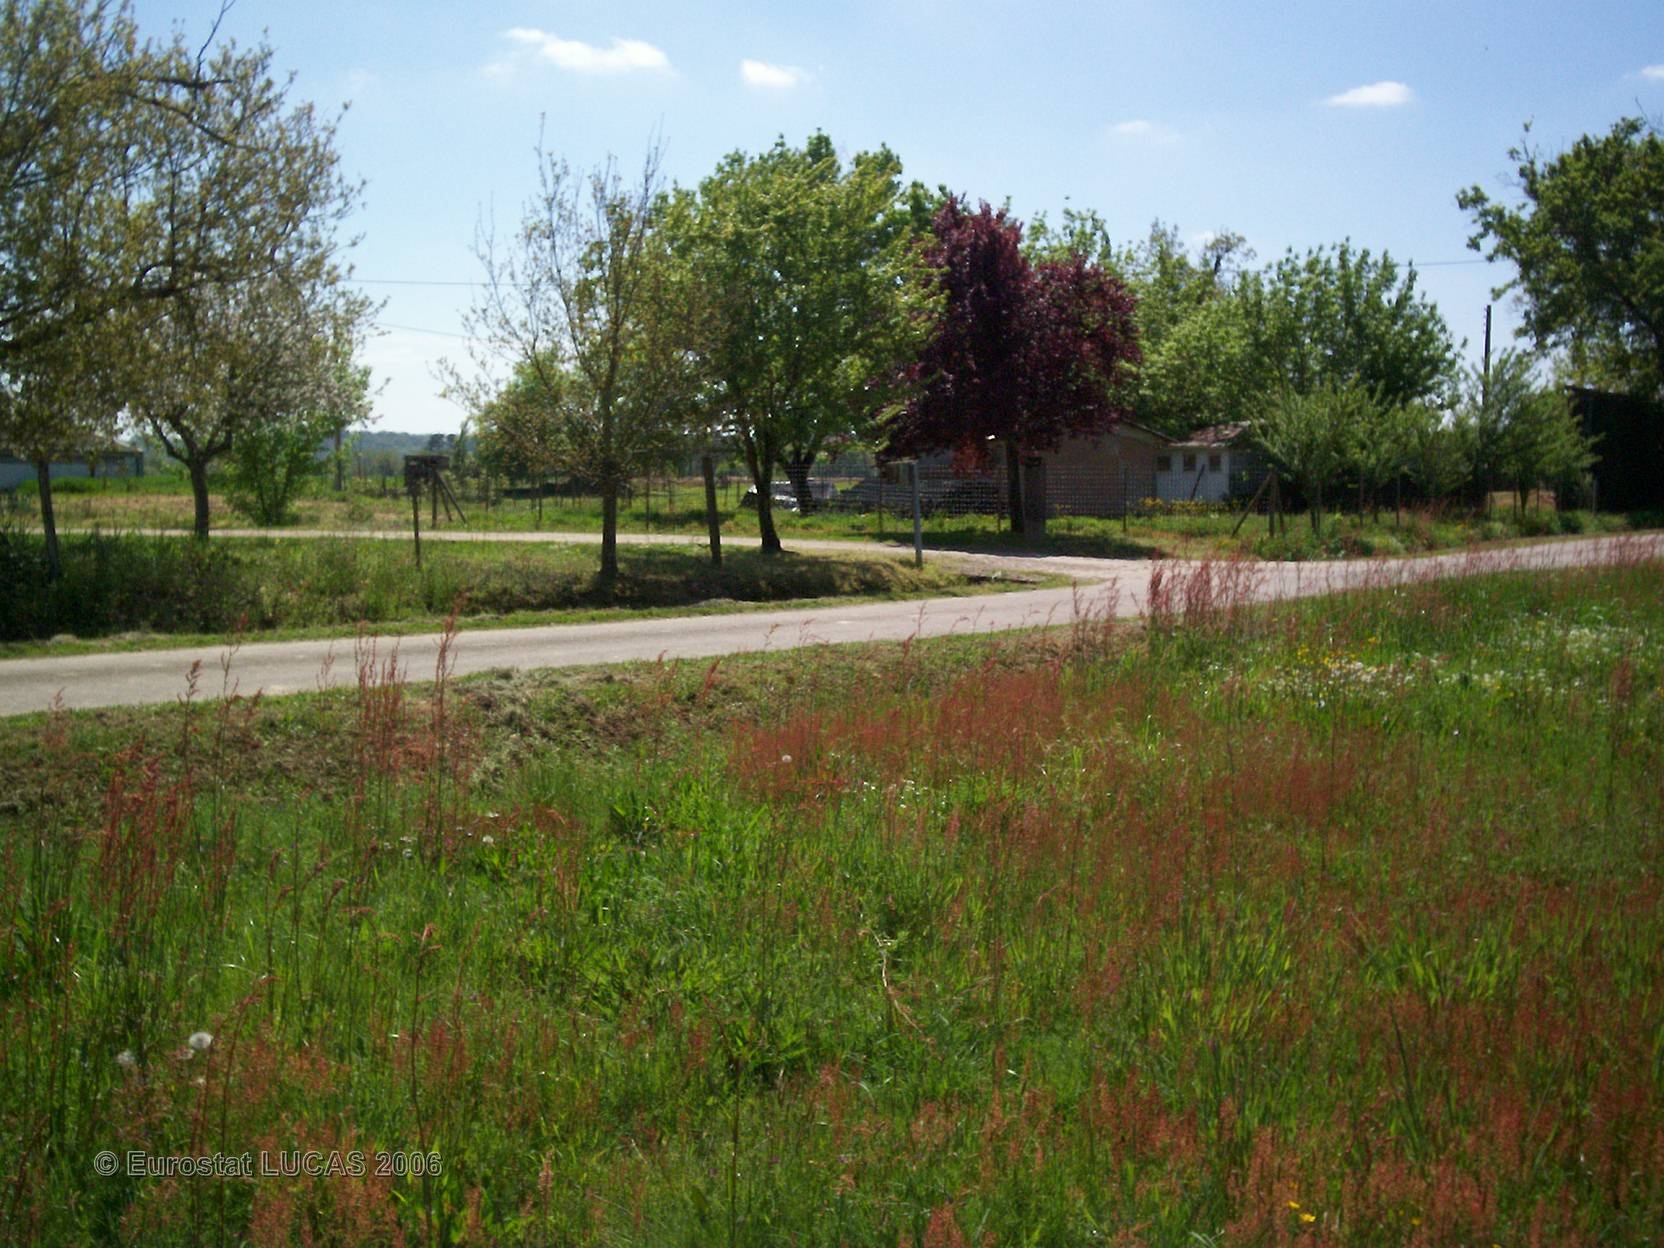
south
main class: Grassland
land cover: Grassland without tree/shrub cover
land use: Agriculture (excluding fallow land and kitchen gardens)
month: April
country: FR
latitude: 43.7765
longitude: -0.7103
